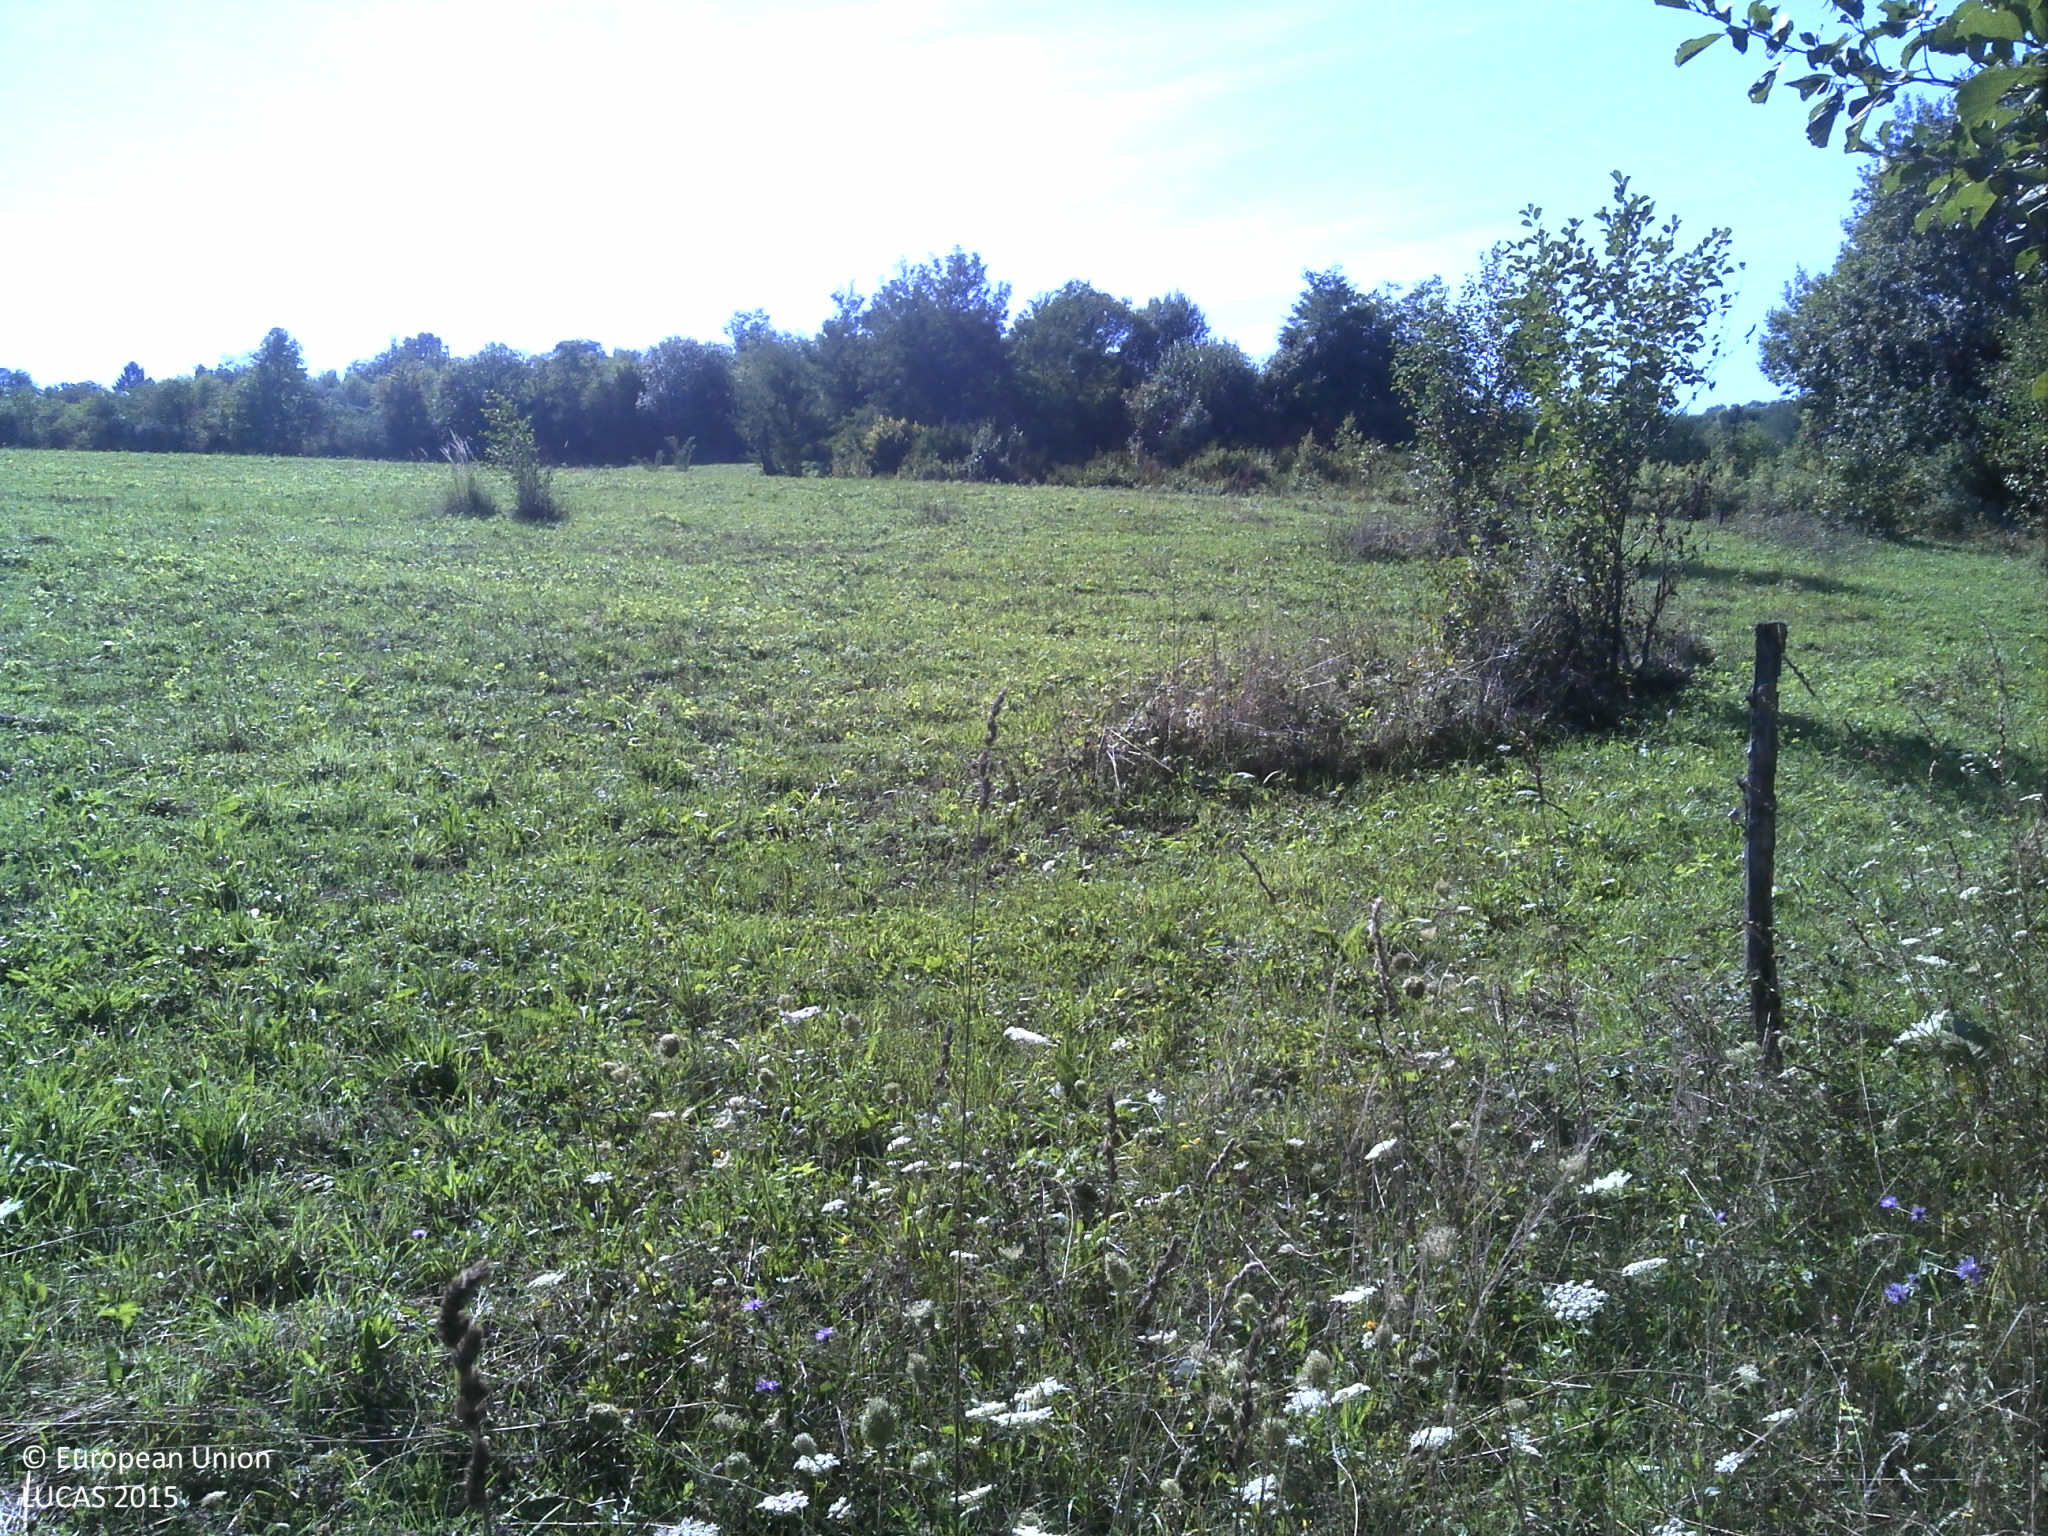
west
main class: Grassland
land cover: Grassland without tree/shrub cover
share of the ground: > 75 %
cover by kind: herbaceous plants 100 %
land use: Semi-natural and natural areas not in use
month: August
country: HR
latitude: 45.3304
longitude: 16.3642
